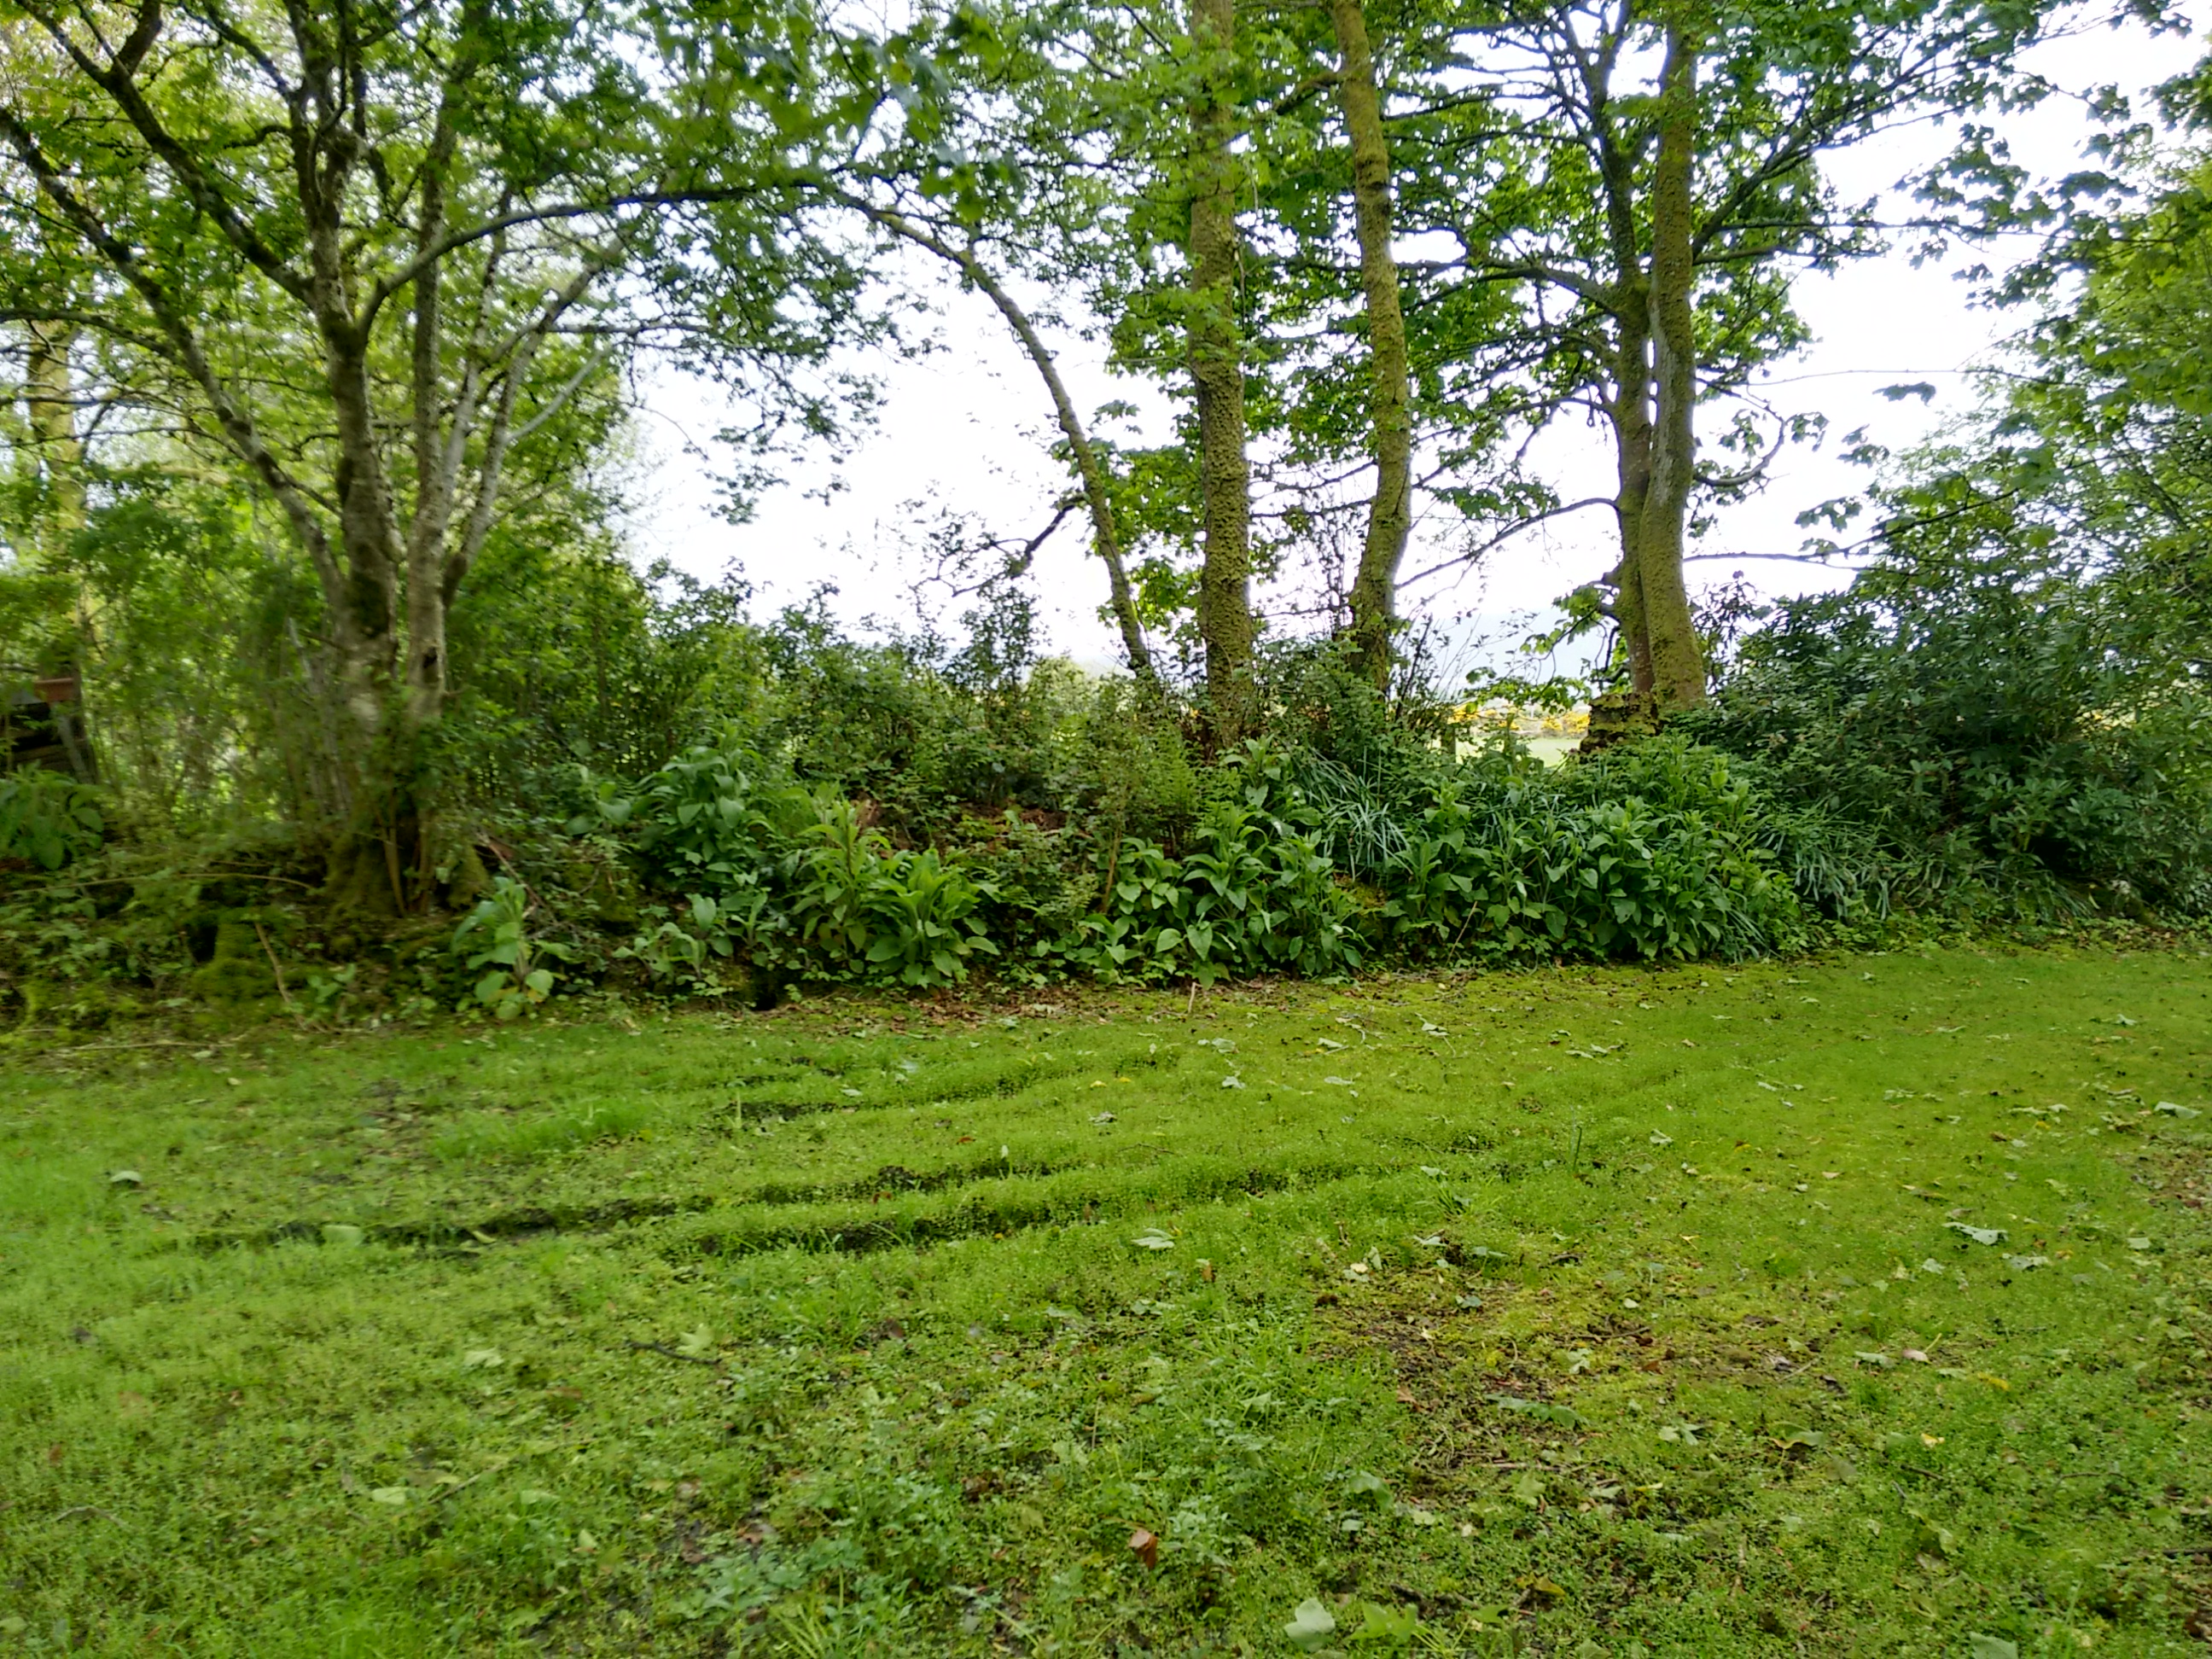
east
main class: Woodland
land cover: Broadleaved woodland
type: mesophytic deciduous forest
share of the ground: > 75 %
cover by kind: broadleaved forest trees 100 %
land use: Semi-natural and natural areas not in use
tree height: > 5 m
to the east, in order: Broadleaved woodland; Tracks; Grass margins; Dry stone walls; Fences; Grassland without tree/shrub cover; Fences; Abandoned hedges; Ditches and canals; Peatbogs; Shrubland with sparse tree cover; Peatbogs; Single bushes/trees; Shrubland with sparse tree cover; Fences; Grassland without tree/shrub cover
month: June
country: GB
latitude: 54.9894
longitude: -6.9692
